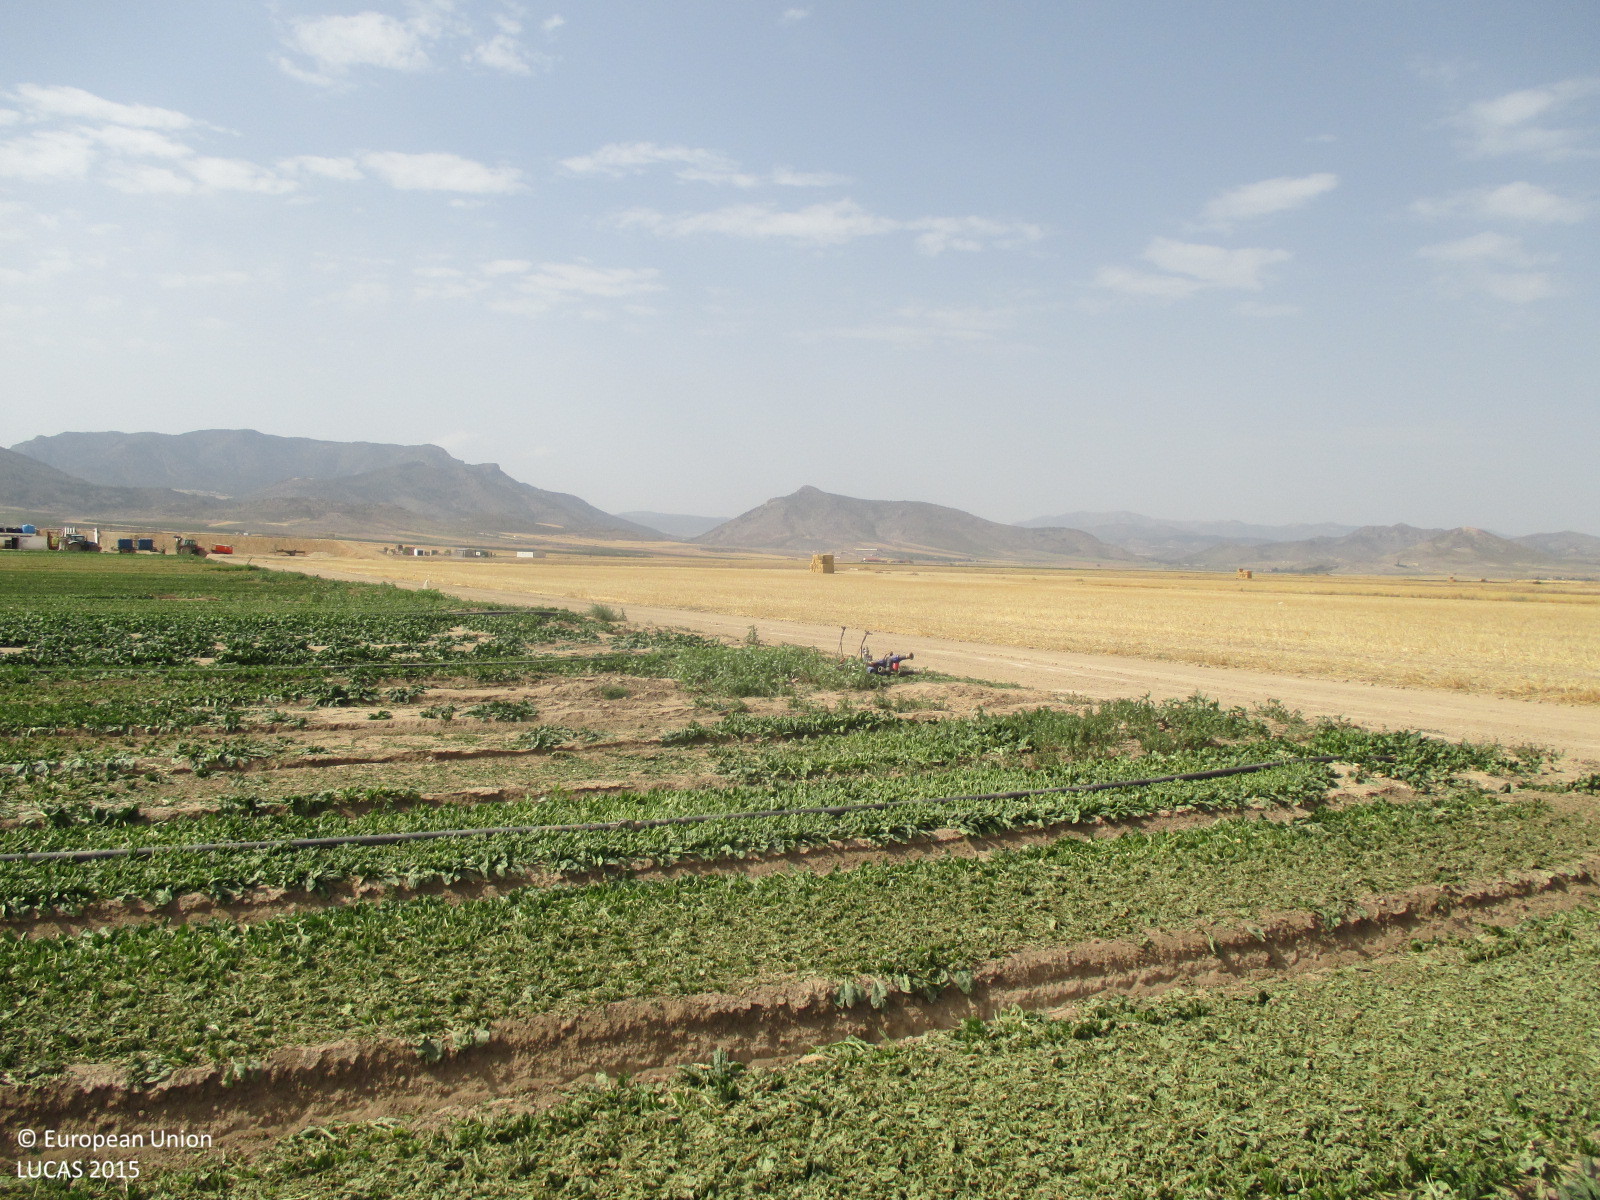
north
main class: Cropland
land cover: Other fresh vegetables
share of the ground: 50 - 75 %
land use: Agriculture (excluding fallow land and kitchen gardens)
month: July
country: ES
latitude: 37.8652
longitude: -2.4141
